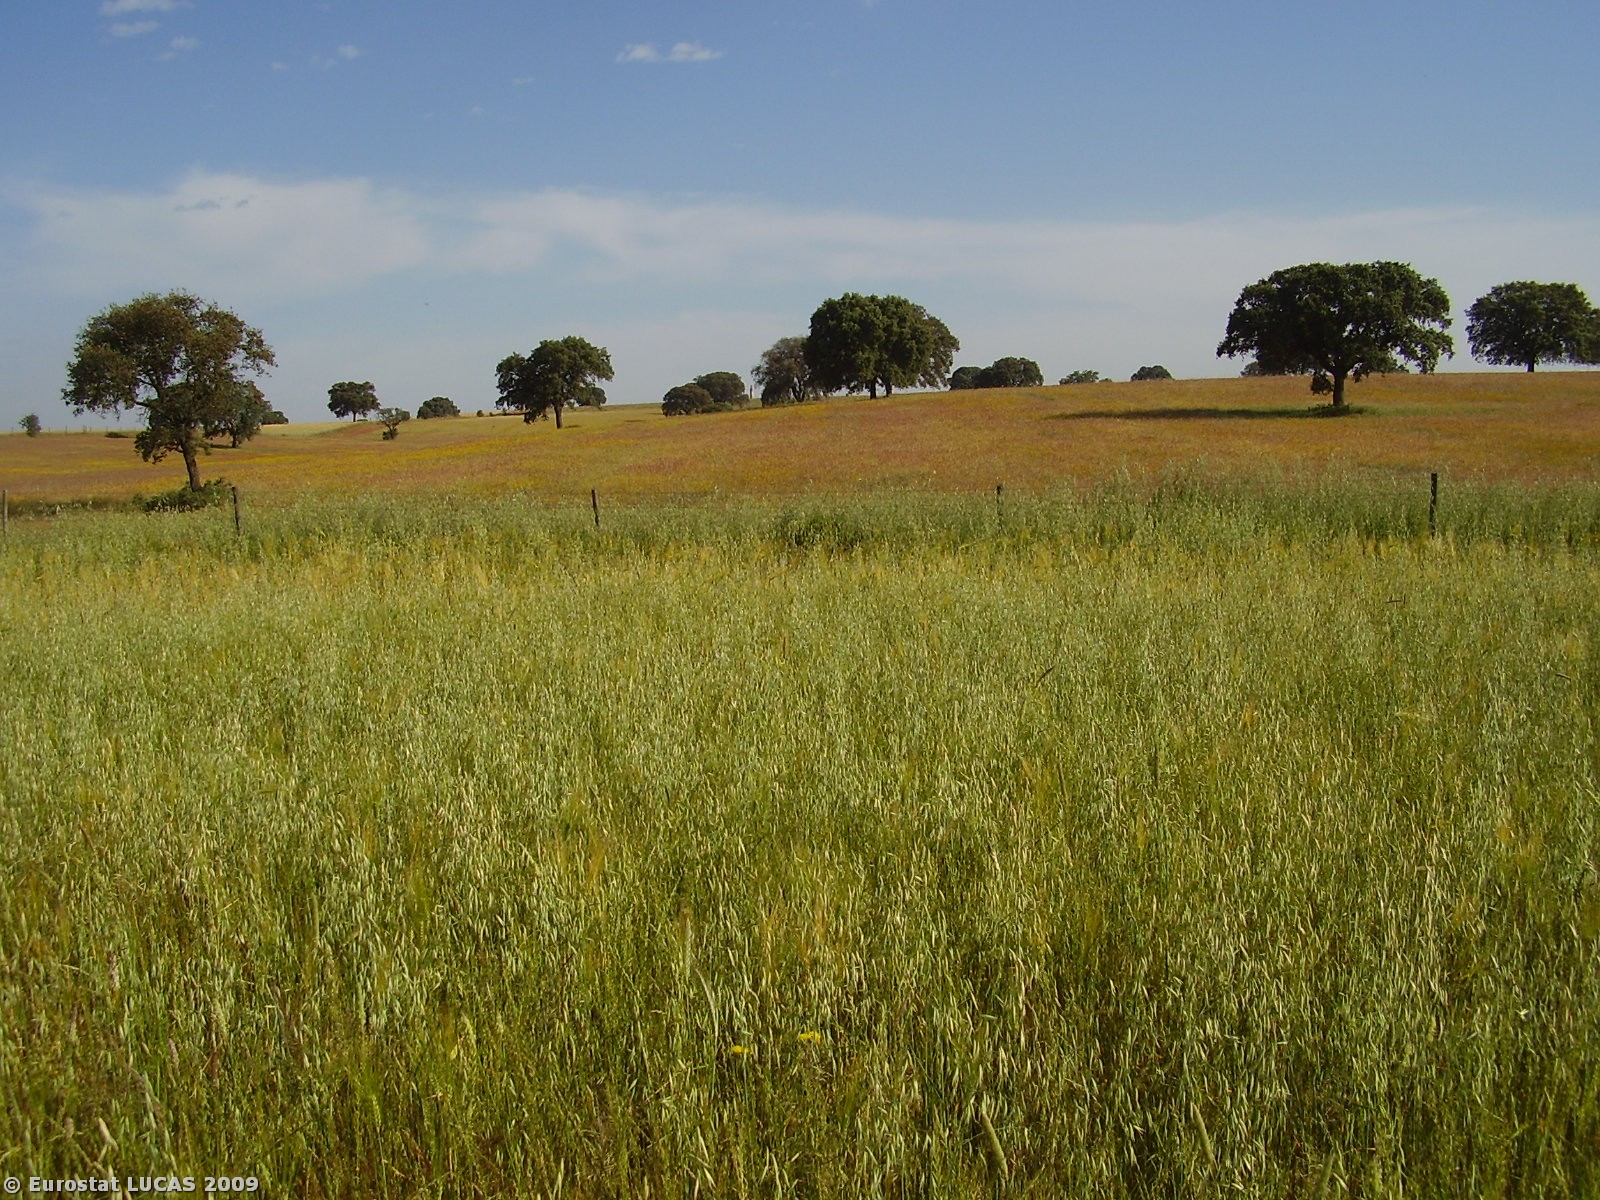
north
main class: Cropland
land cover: Mixed cereals for fodder
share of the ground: > 75 %
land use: Agriculture (excluding fallow land and kitchen gardens)
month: May
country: PT
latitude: 37.9531
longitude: -7.9299
